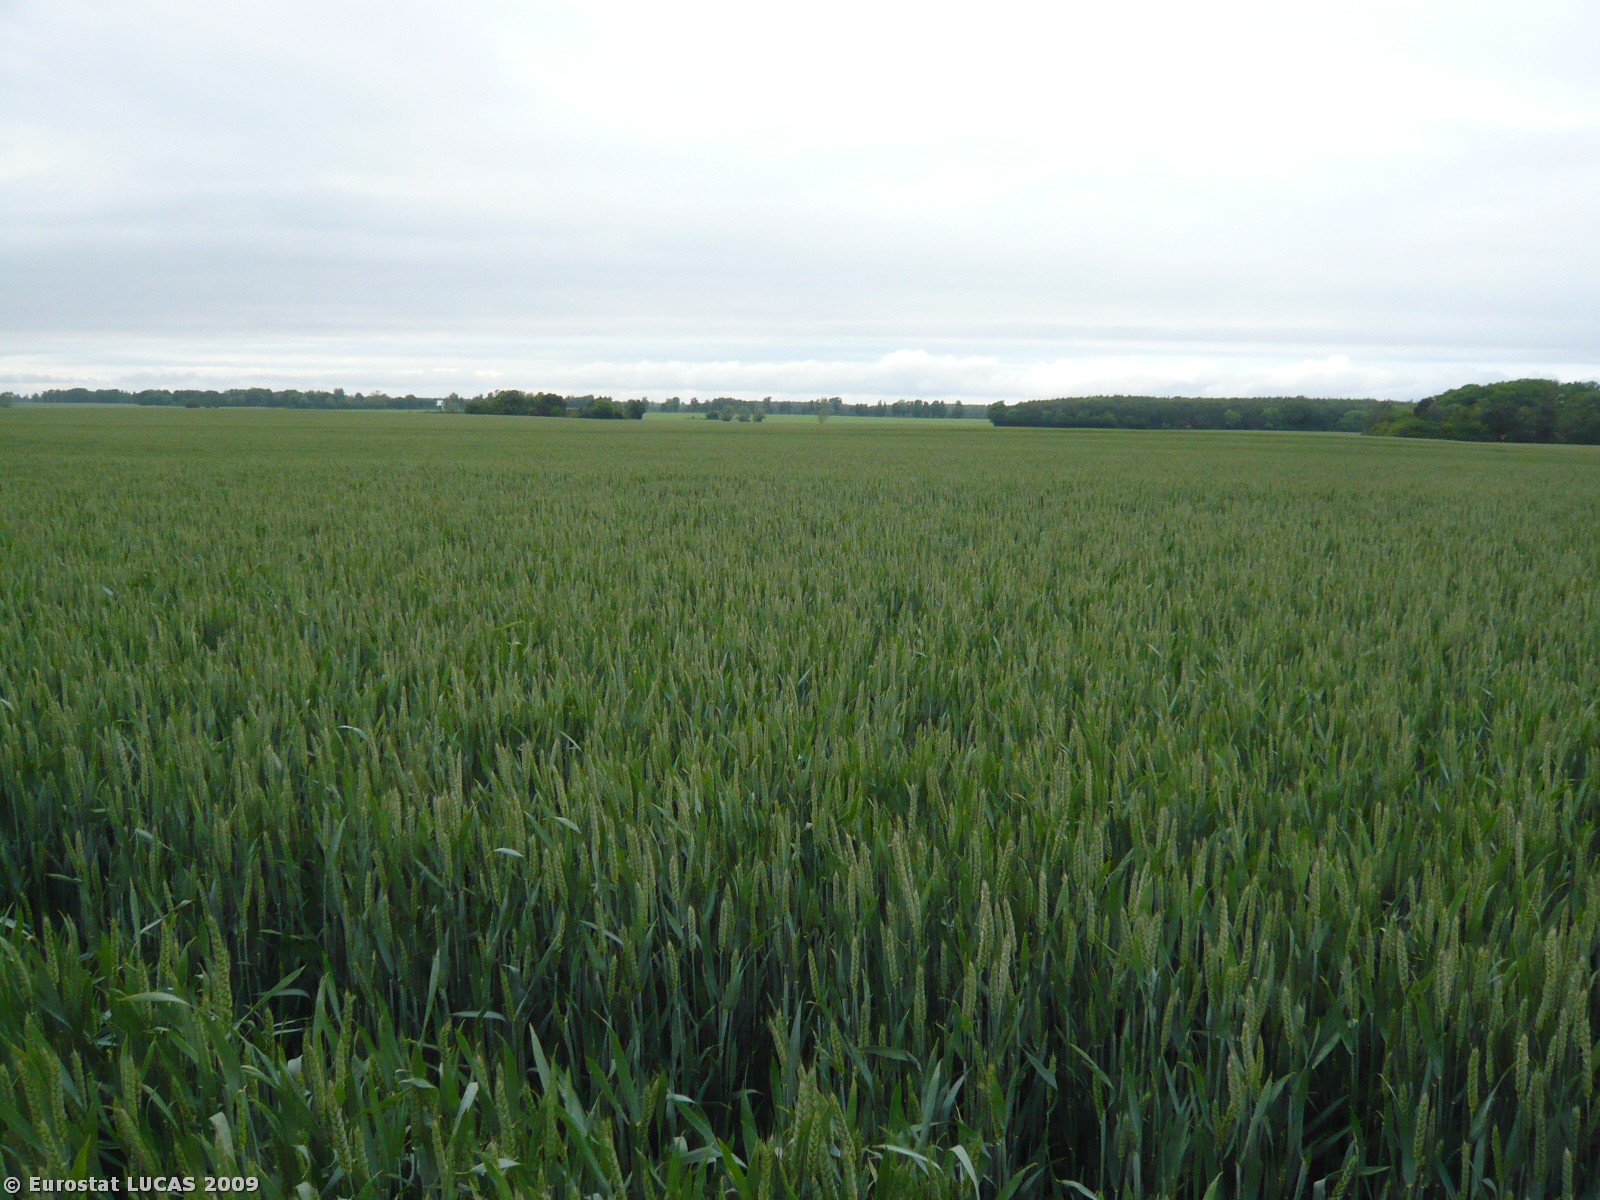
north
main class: Cropland
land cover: Common wheat
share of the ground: > 75 %
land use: Agriculture (excluding fallow land and kitchen gardens)
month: June
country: DK
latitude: 54.7512
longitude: 12.0341
